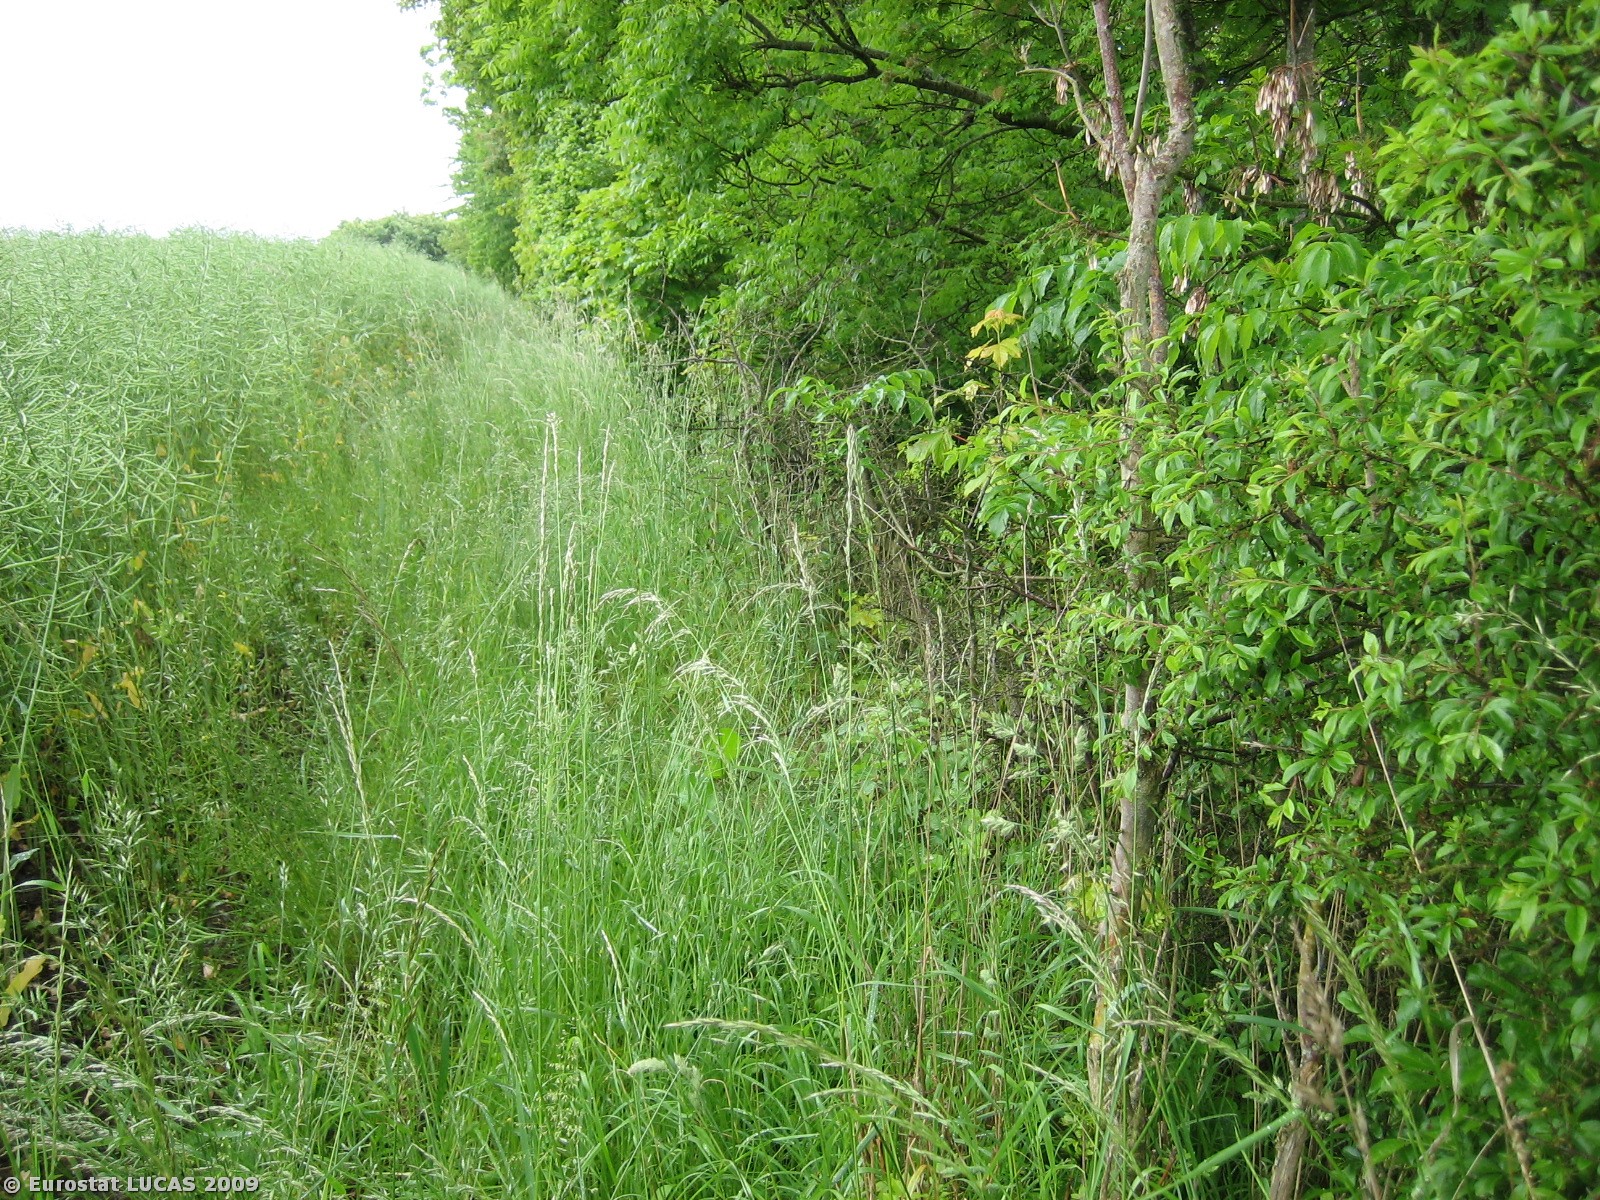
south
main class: Cropland
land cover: Rape and turnip rape
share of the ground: > 75 %
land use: Agriculture (excluding fallow land and kitchen gardens)
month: June
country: DK
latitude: 55.9181
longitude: 10.1119
